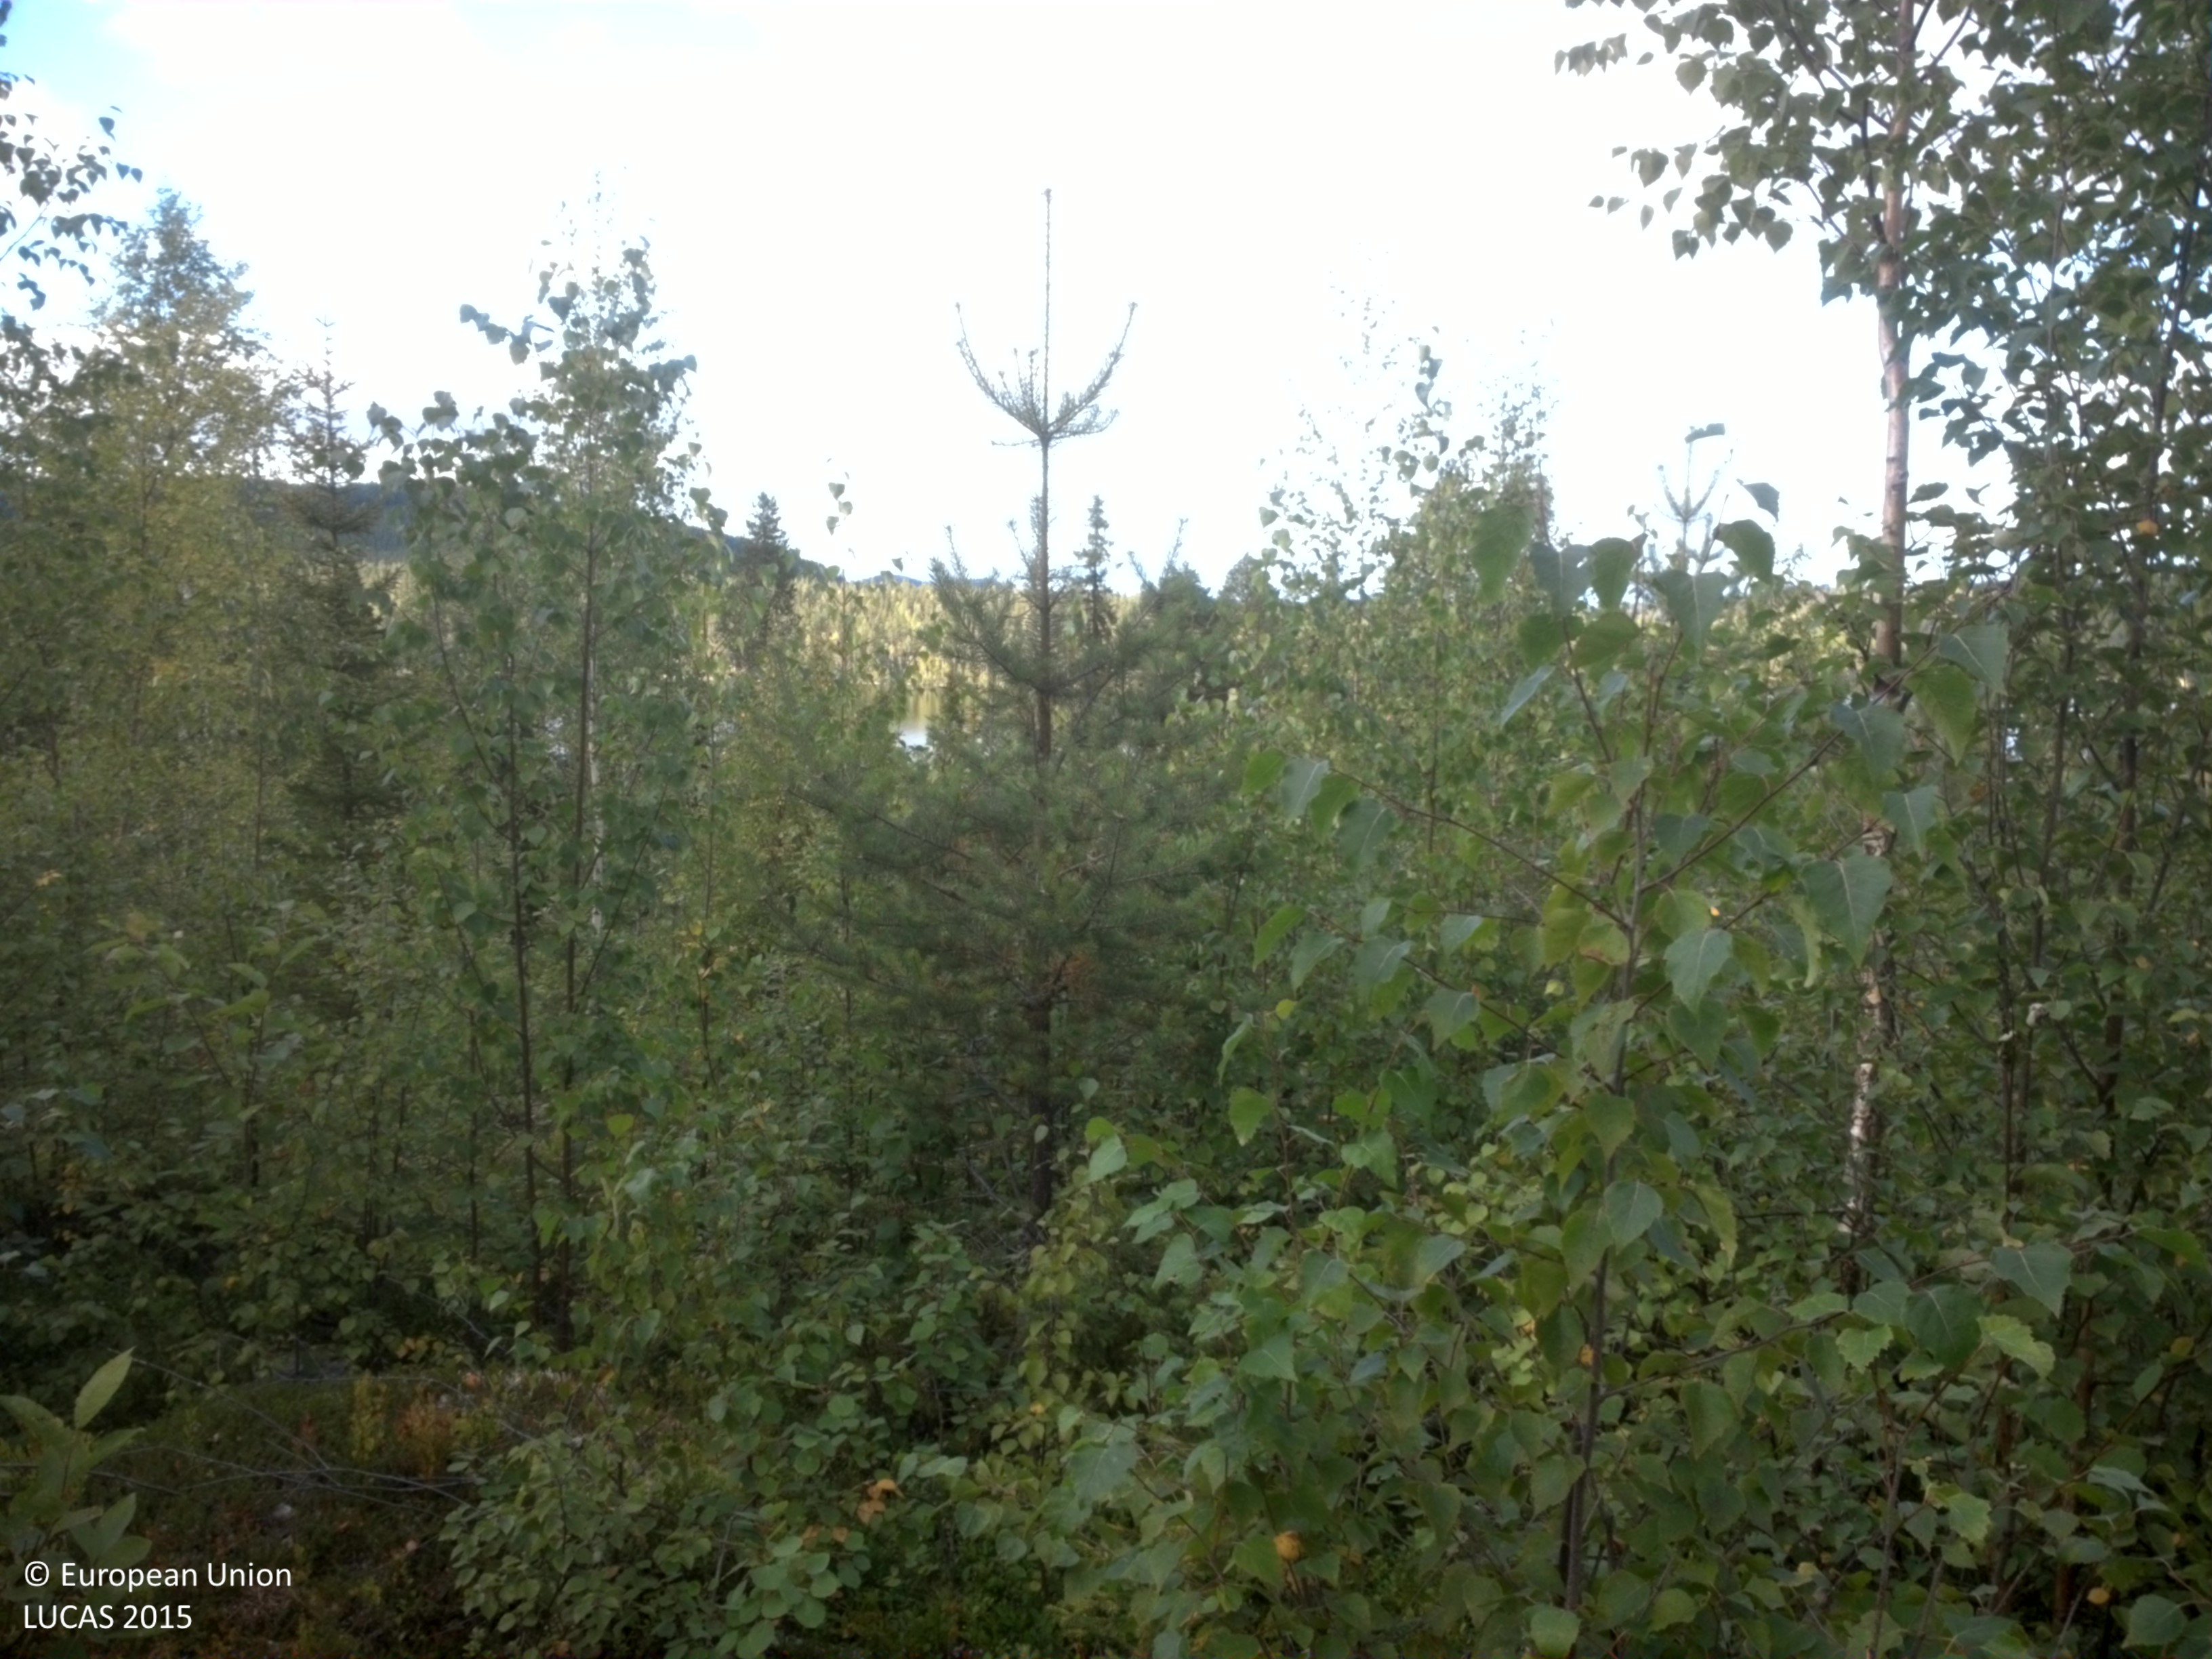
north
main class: Woodland
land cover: Broadleaved woodland
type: boreal forest
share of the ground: 50 - 75 %
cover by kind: broadleaved forest trees 60 %, shrubs 15 %, coniferous forest trees 10 %, lichens and mosses 10 %, herbaceous plants 5 %
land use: Forestry
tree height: > 5 m
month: September
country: SE
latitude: 64.4309
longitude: 19.0452
